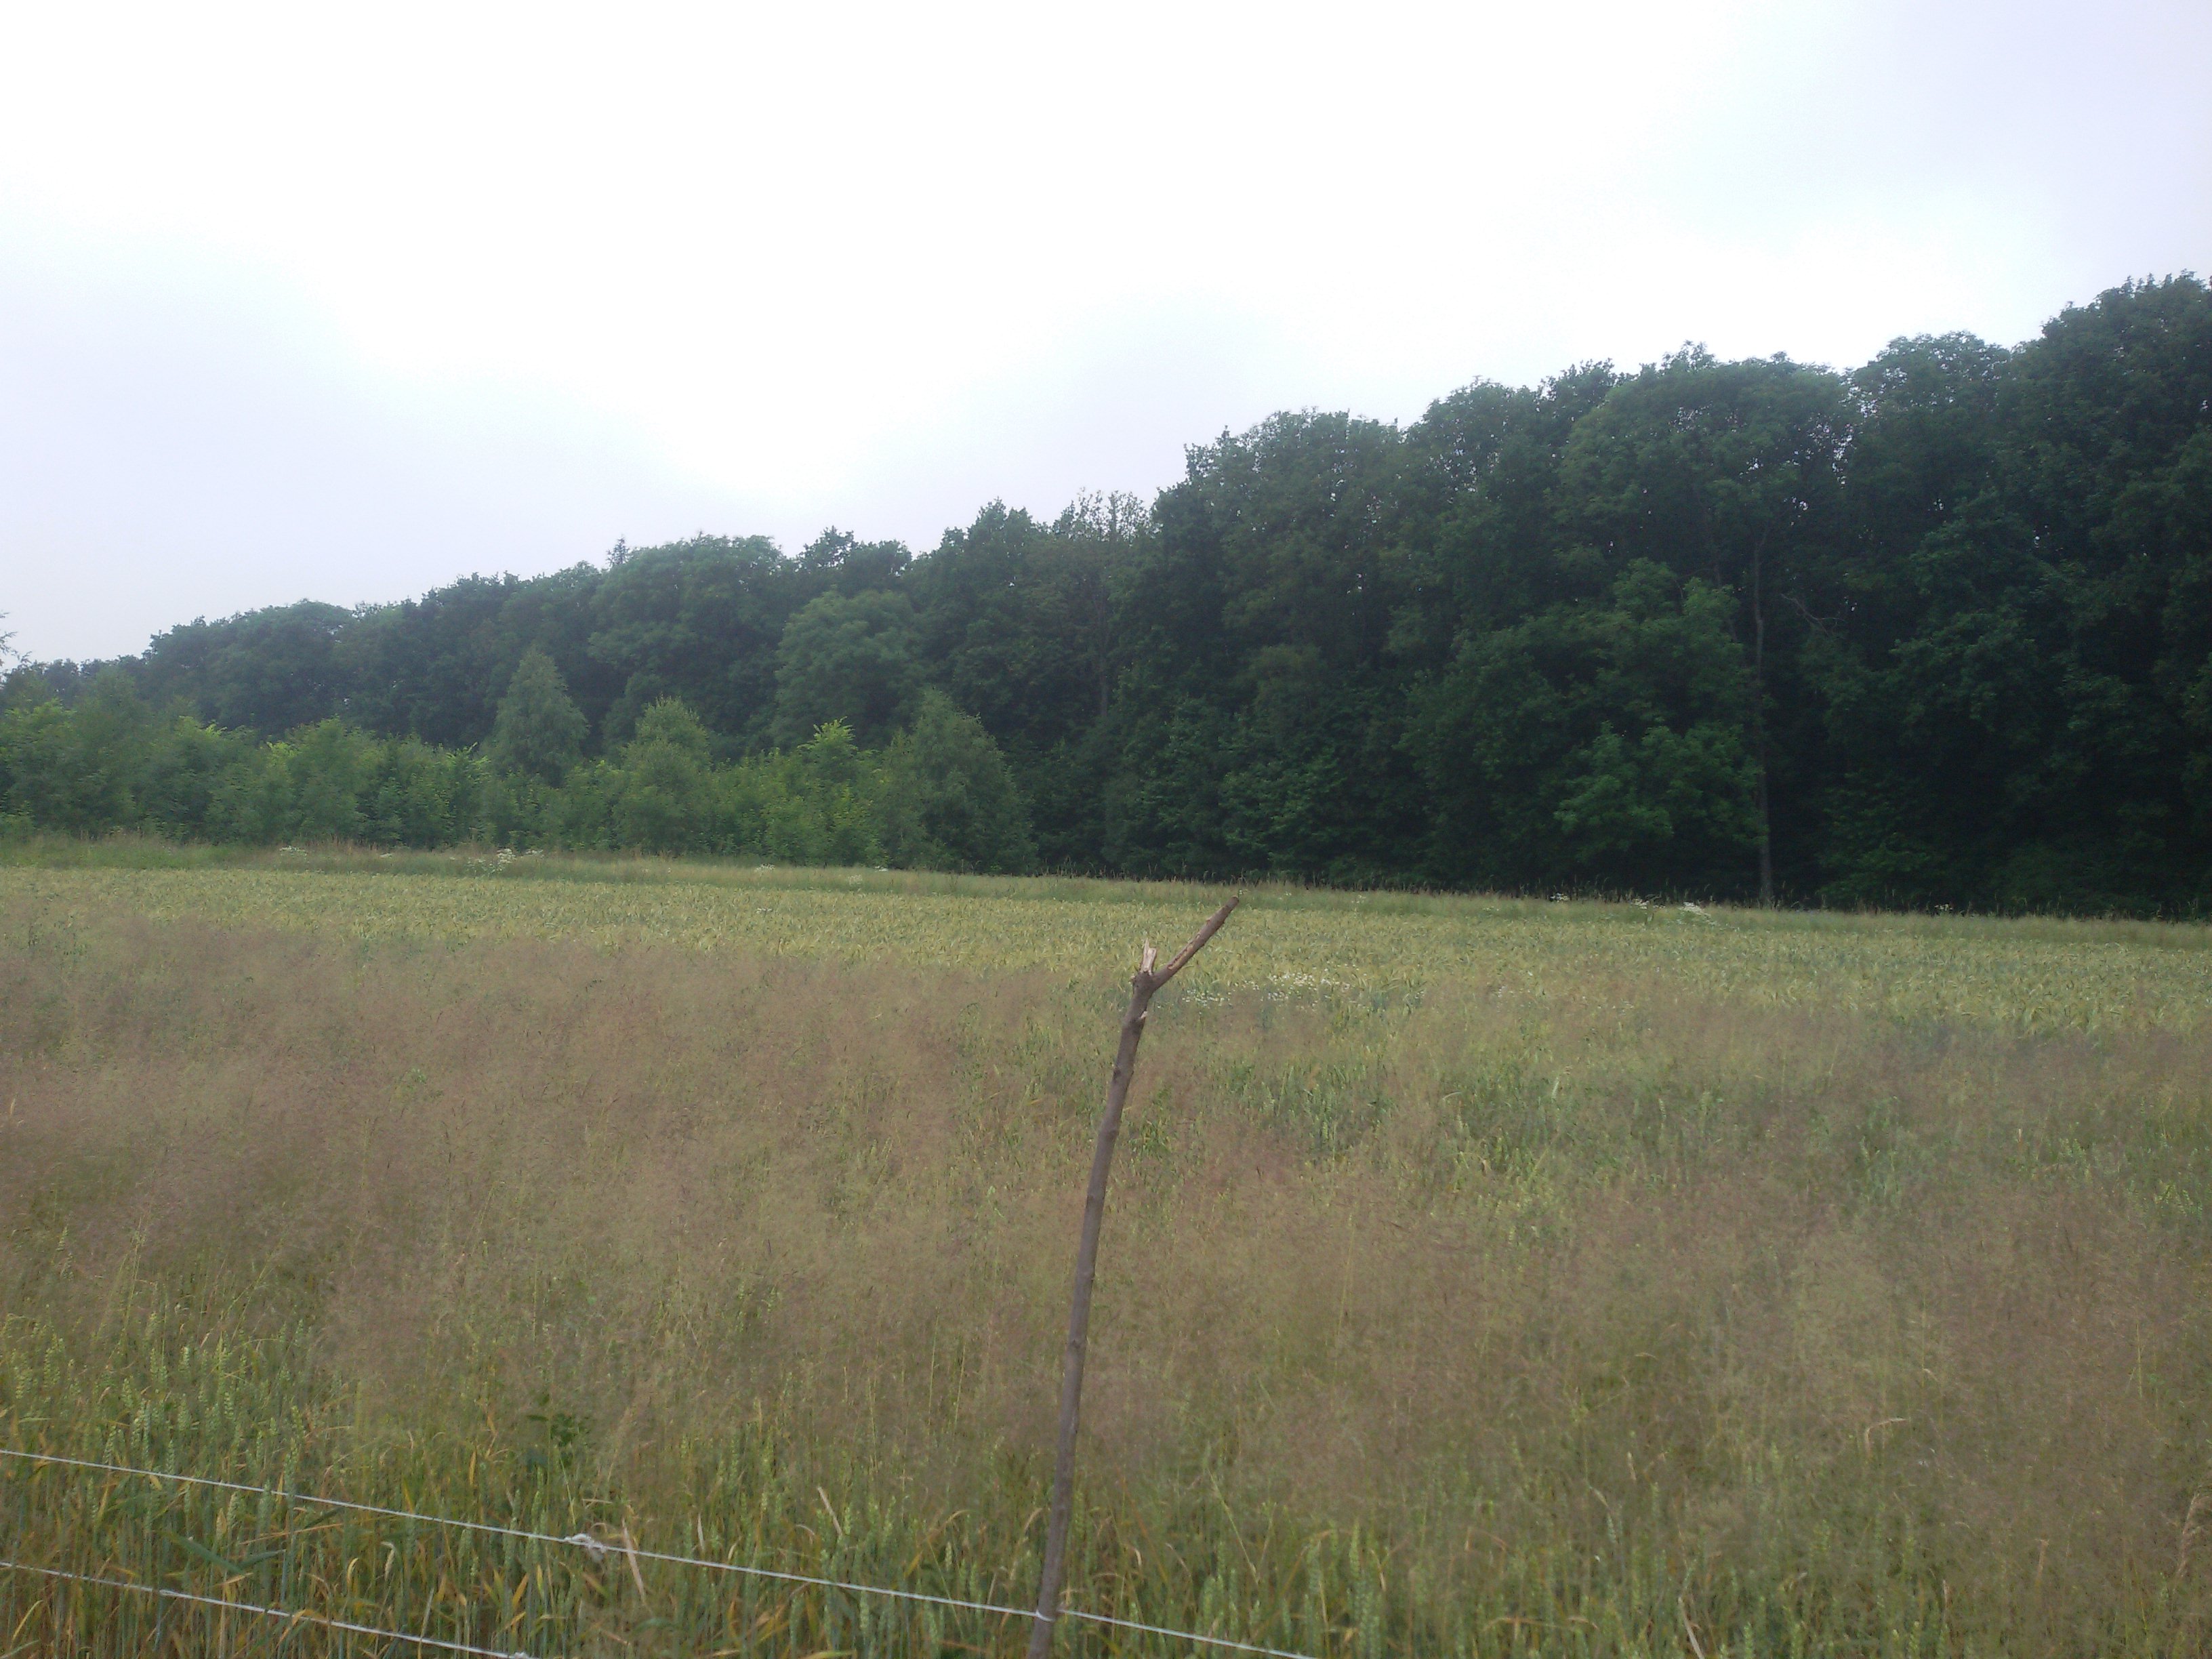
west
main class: Cropland
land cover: Potatoes
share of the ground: > 75 %
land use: Agriculture (excluding fallow land and kitchen gardens)
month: June
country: PL
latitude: 49.9859
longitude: 22.3218
